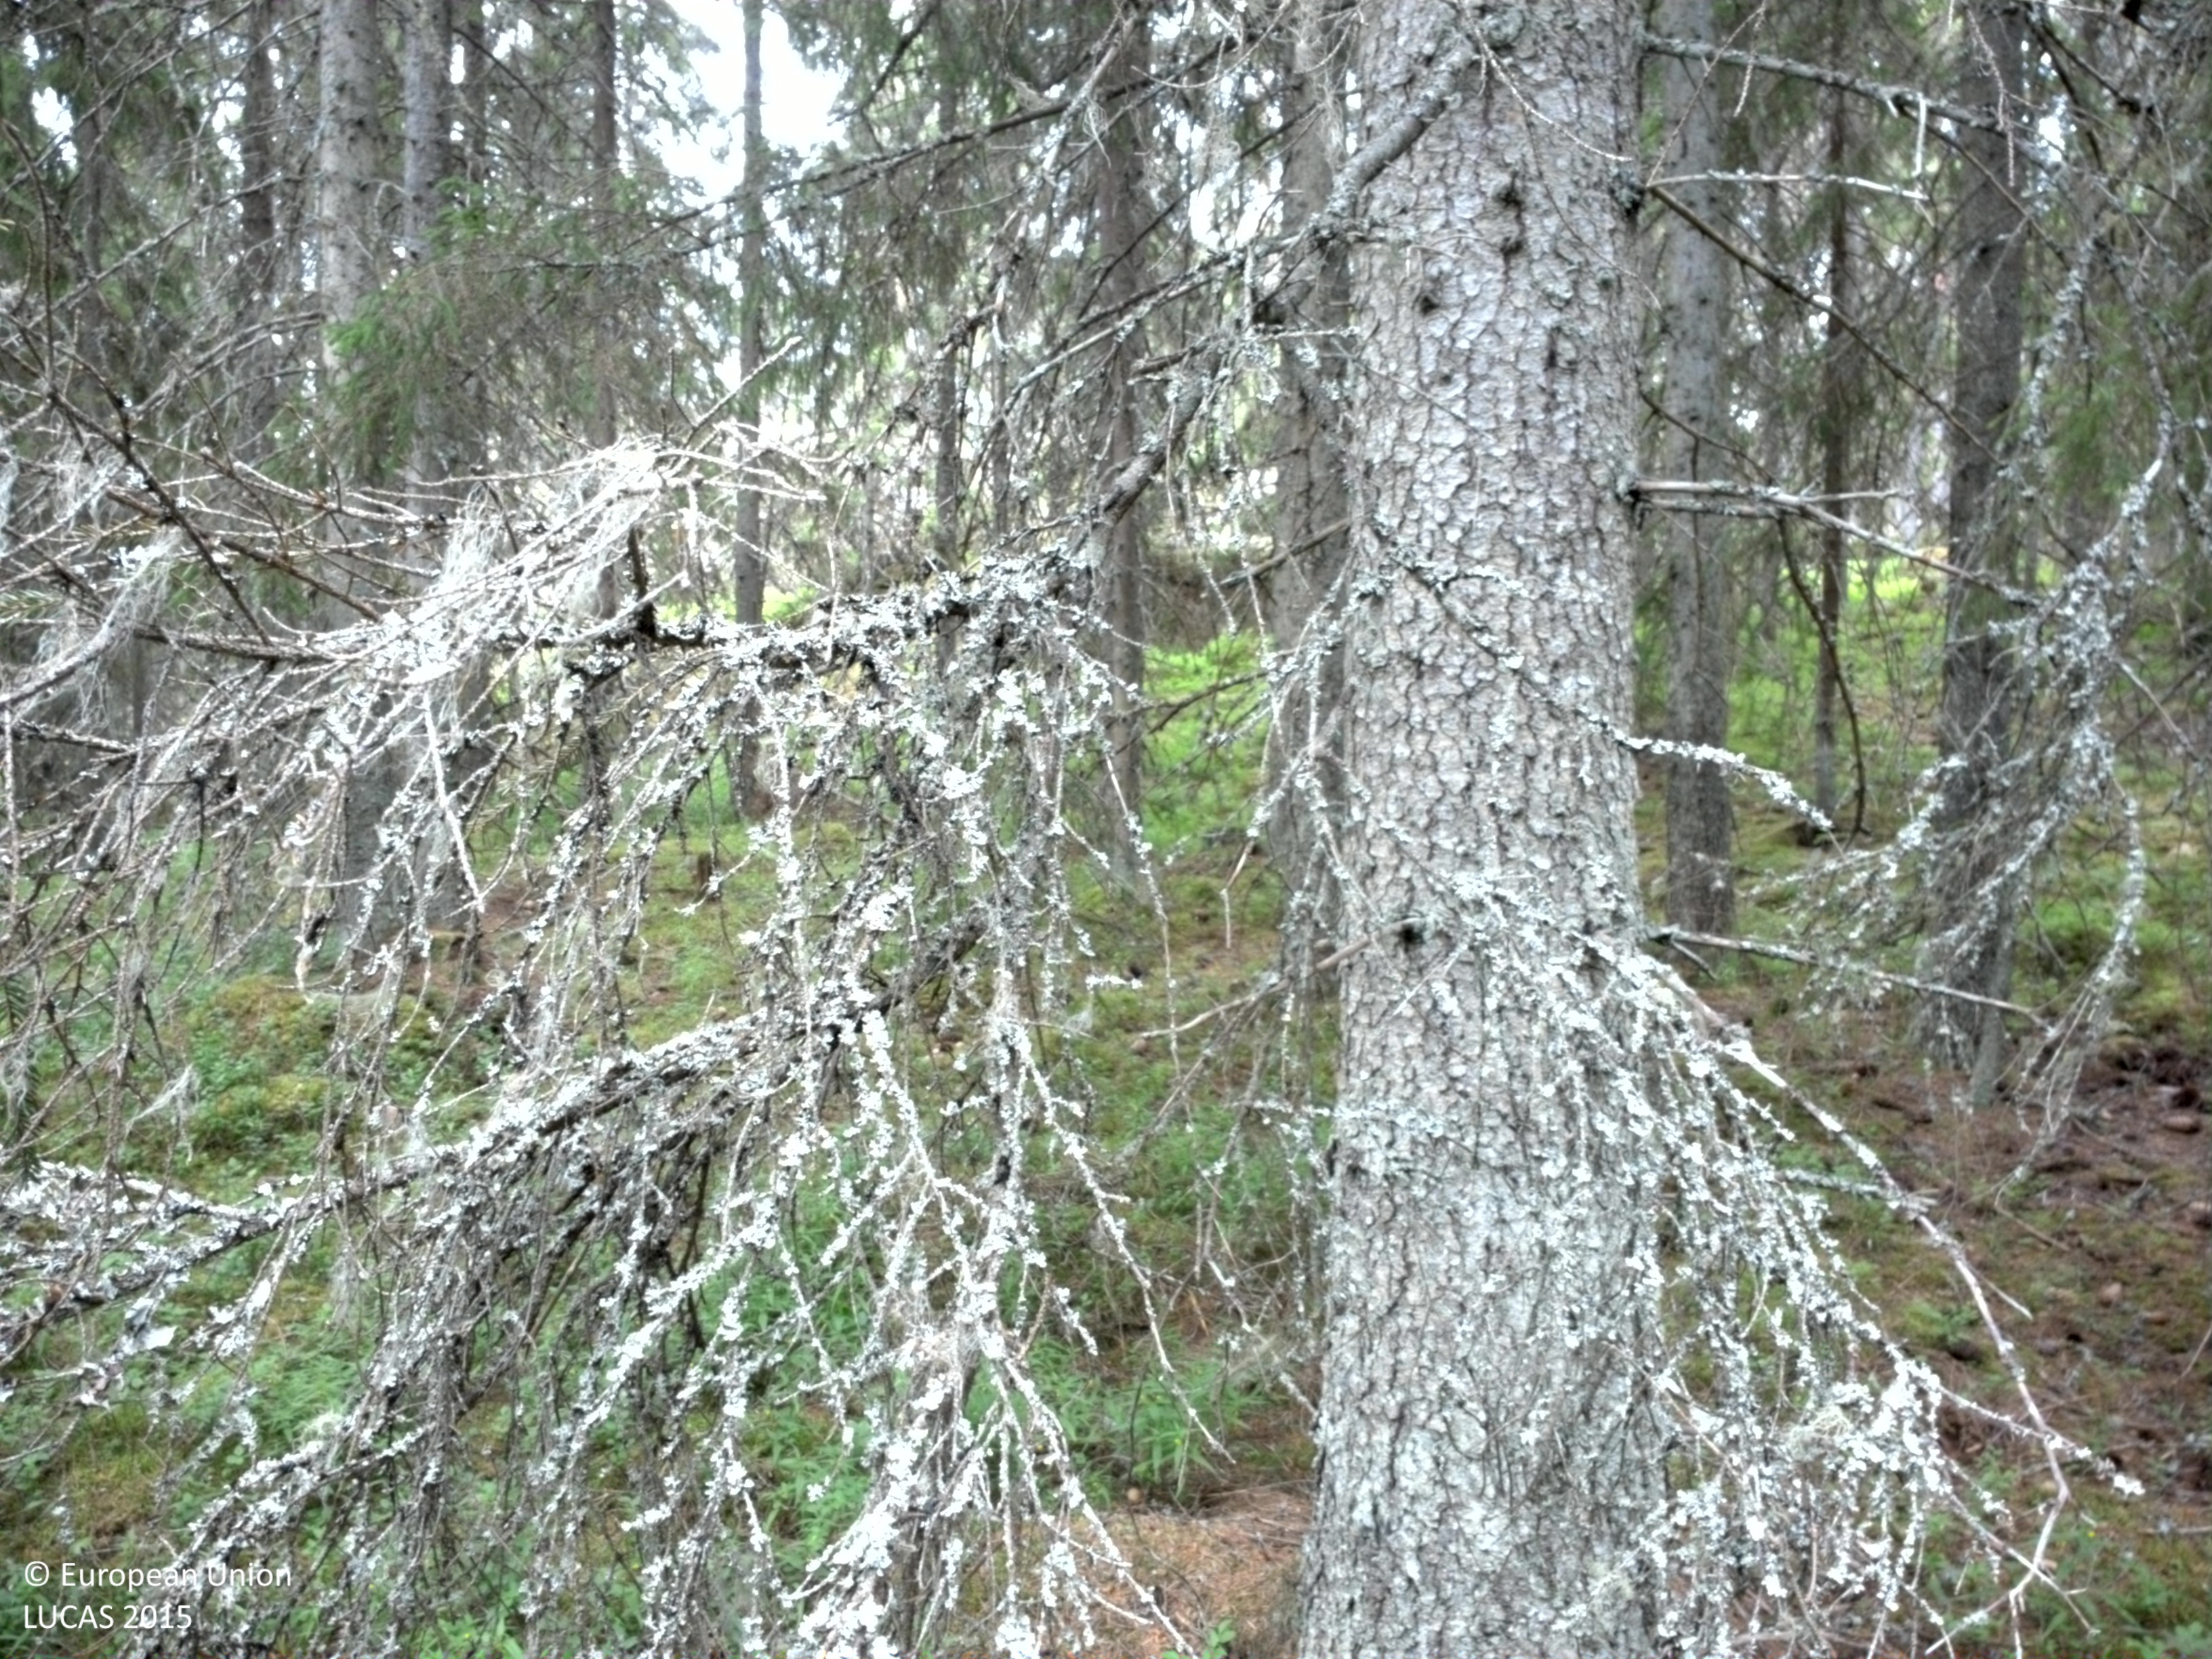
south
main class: Woodland
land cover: Spruce dominated coniferous woodland
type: boreal forest
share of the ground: 50 - 75 %
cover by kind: coniferous forest trees 75 %, lichens and mosses 15 %, herbaceous plants 10 %
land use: Forestry
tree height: > 5 m
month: July
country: SE
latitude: 60.0556
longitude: 18.4203
